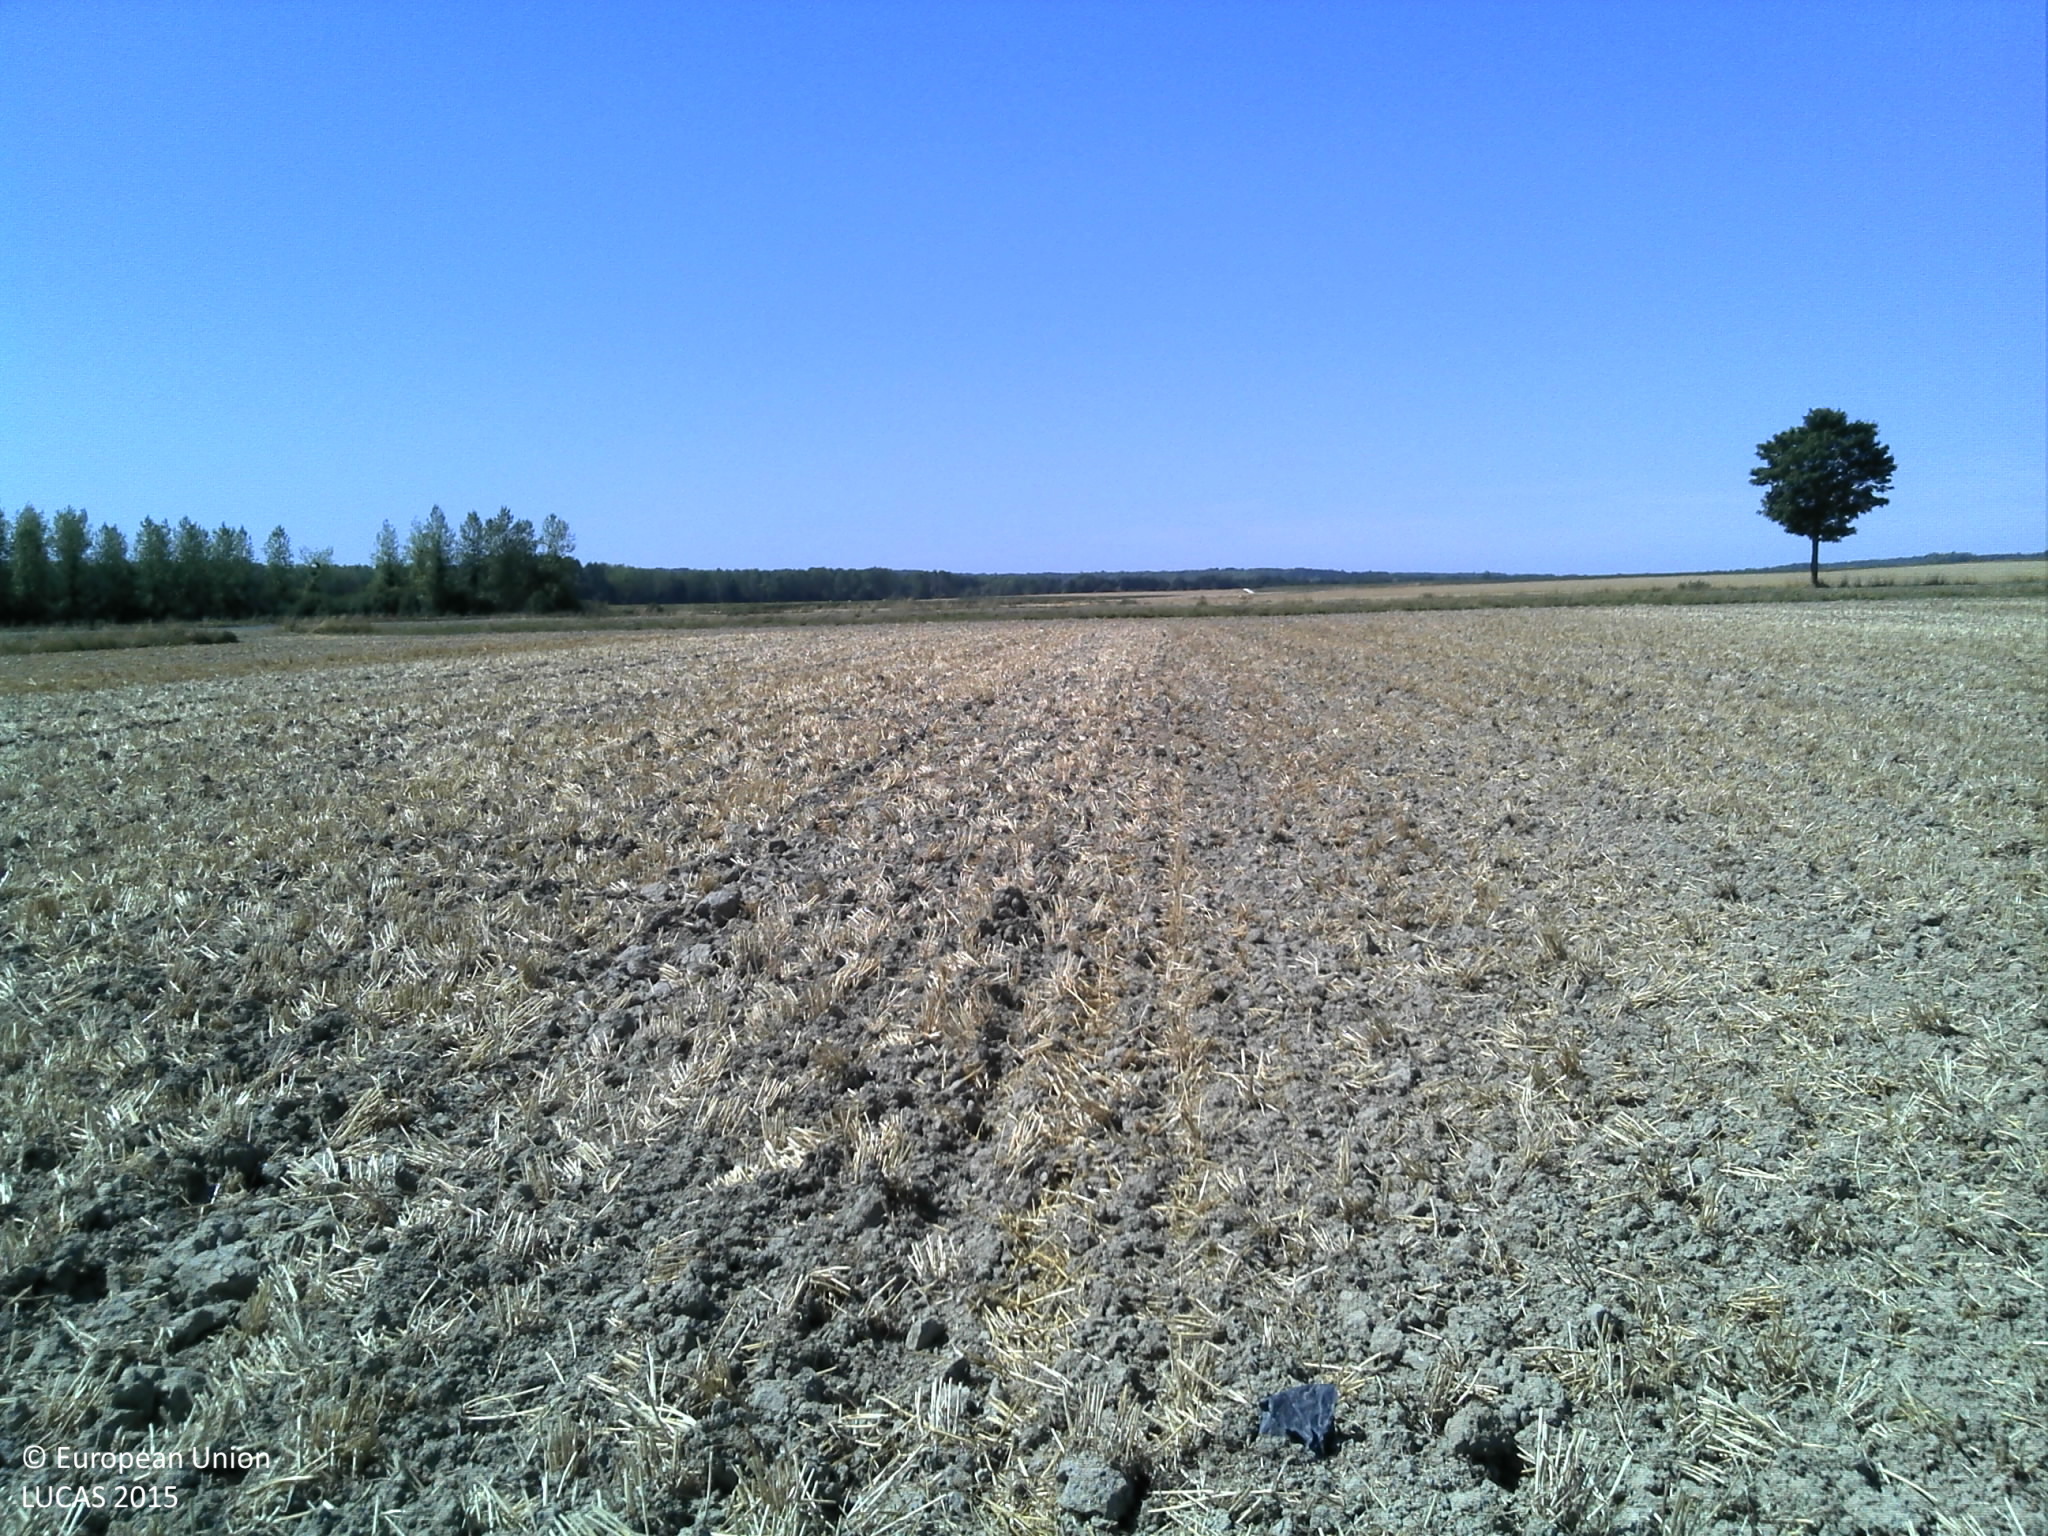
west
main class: Cropland
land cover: Common wheat
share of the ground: > 75 %
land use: Agriculture (excluding fallow land and kitchen gardens)
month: August
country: FR
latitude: 49.2350
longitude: 4.7646
